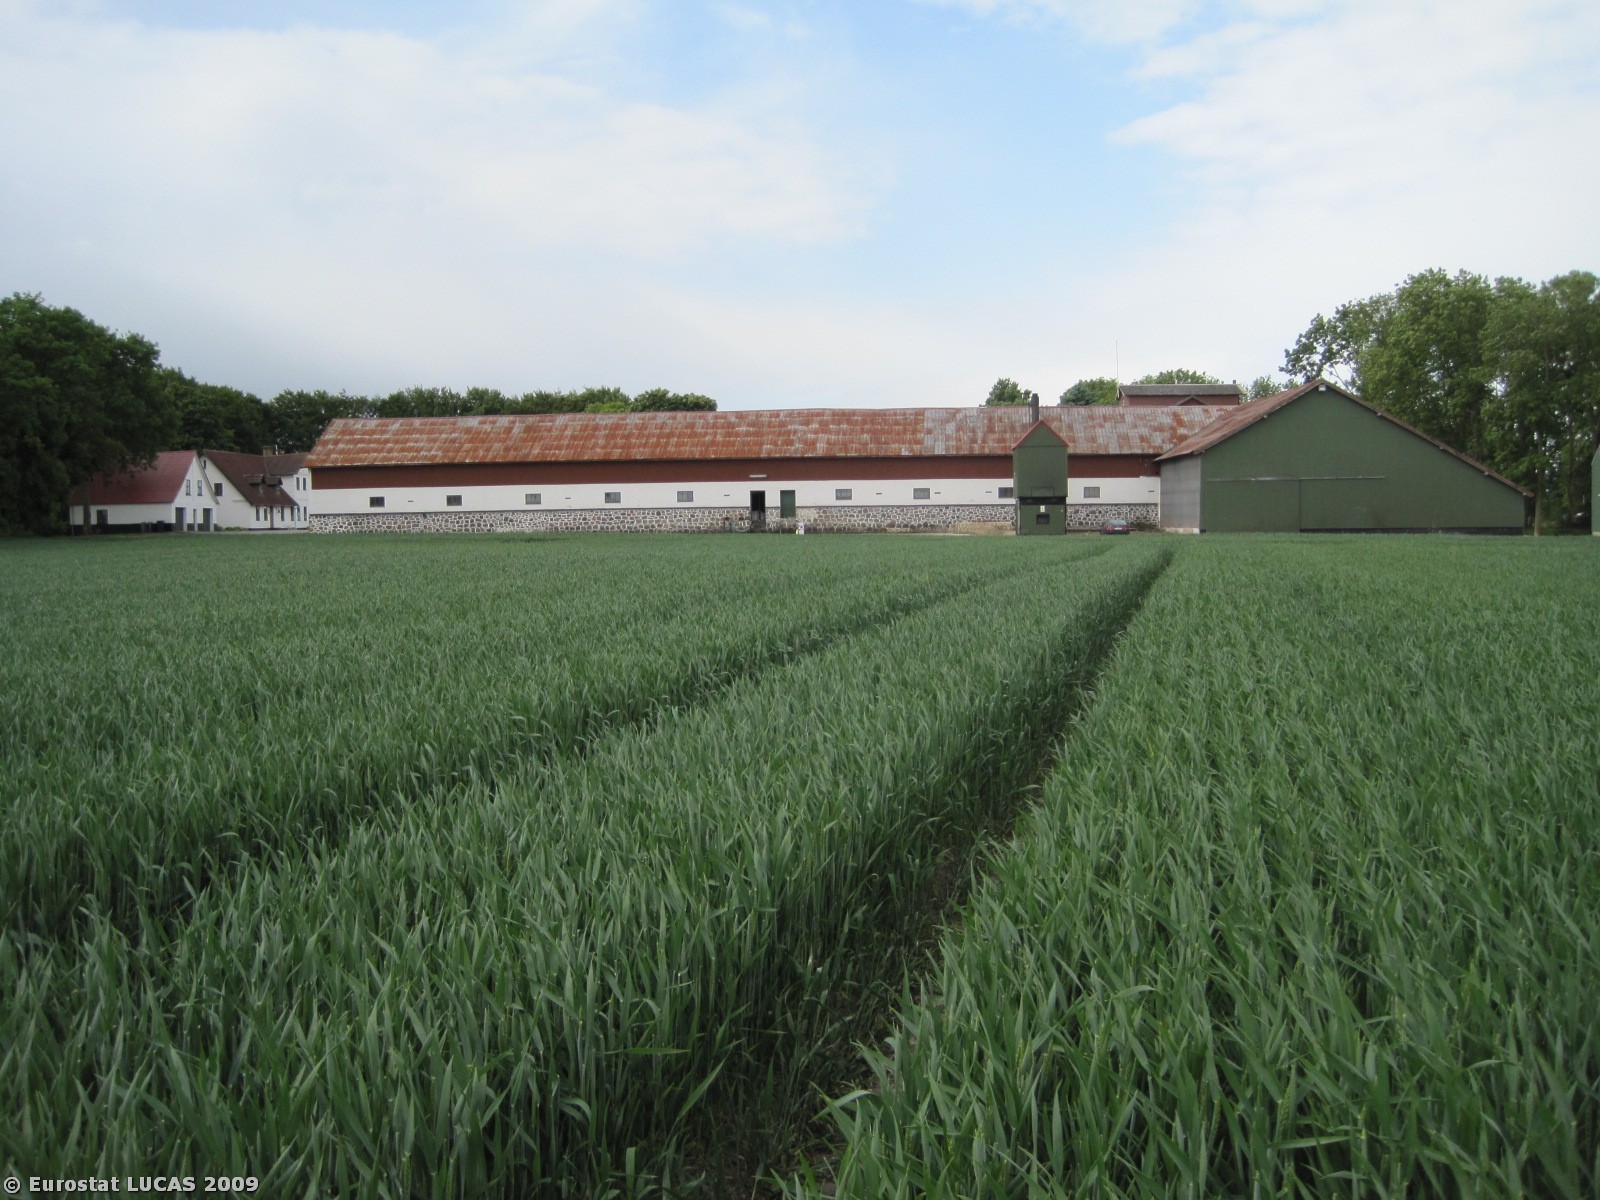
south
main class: Cropland
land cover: Common wheat
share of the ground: > 75 %
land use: Agriculture (excluding fallow land and kitchen gardens)
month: June
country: DK
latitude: 57.0326
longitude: 10.0823
